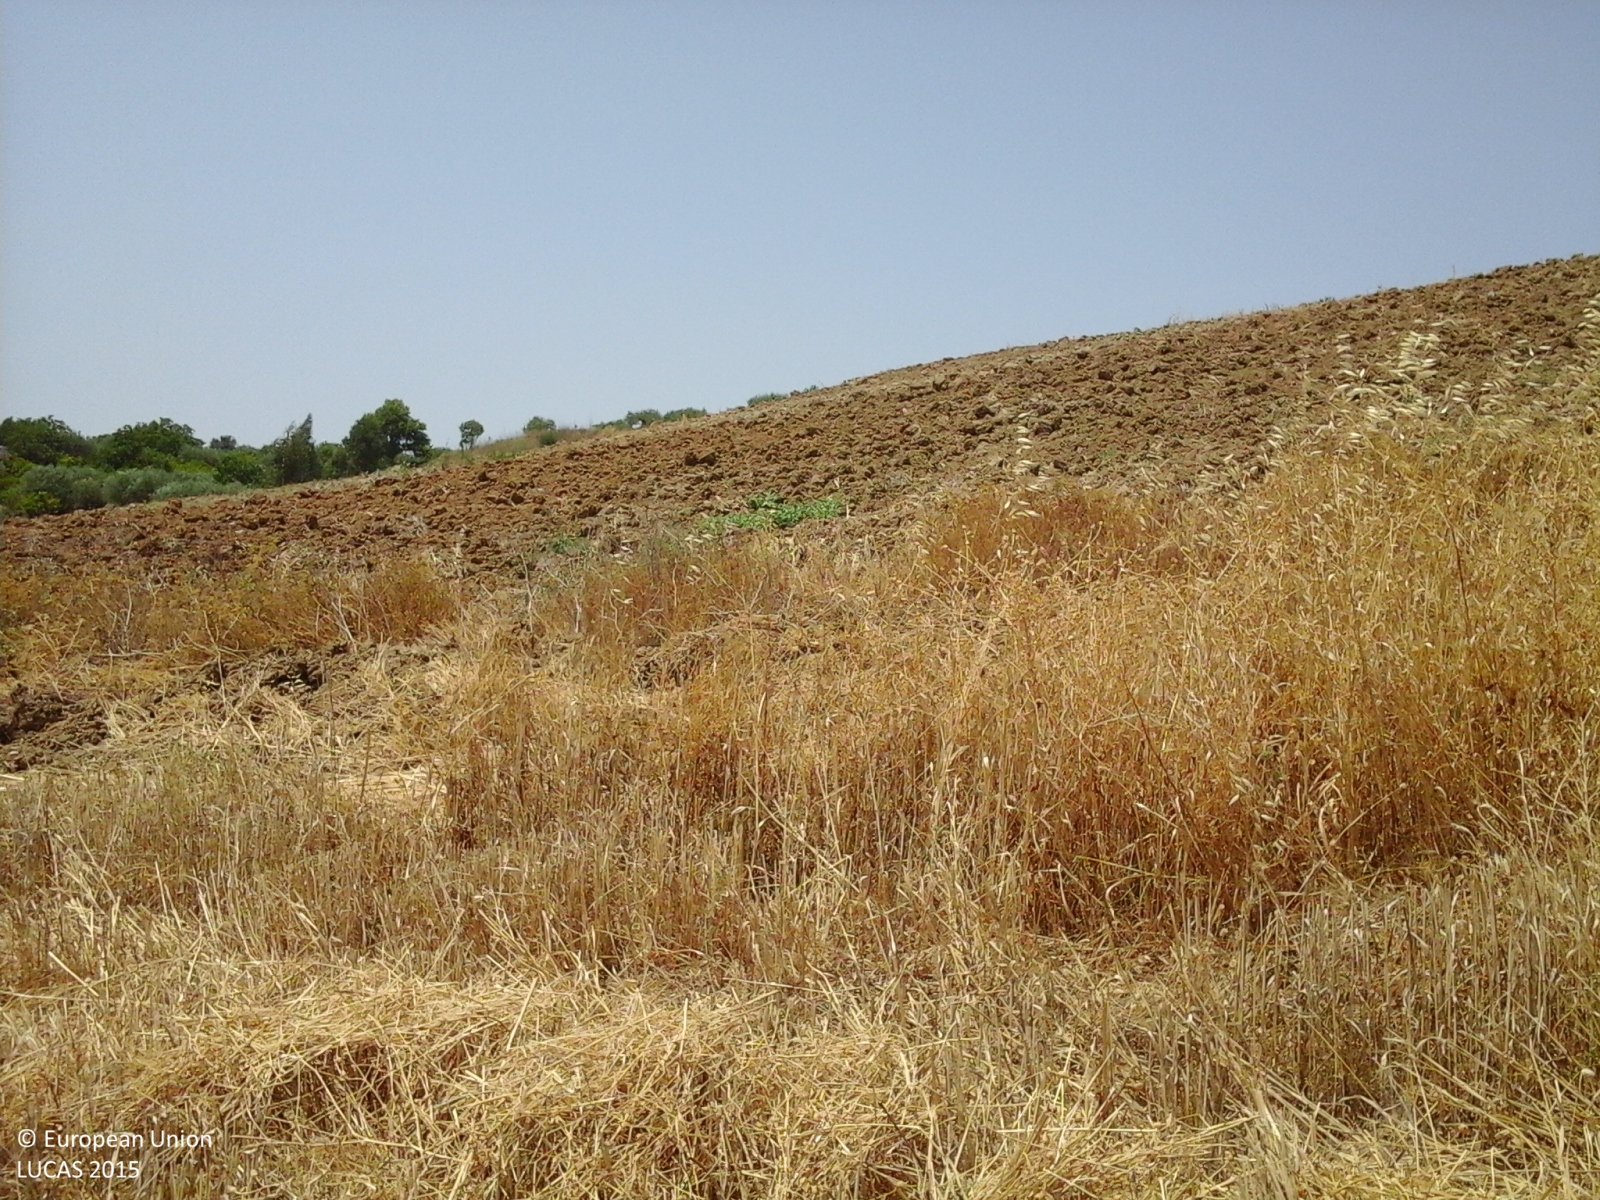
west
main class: Cropland
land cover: Durum wheat
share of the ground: > 75 %
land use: Agriculture (excluding fallow land and kitchen gardens)
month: July
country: IT
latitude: 37.3353
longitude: 14.0211
